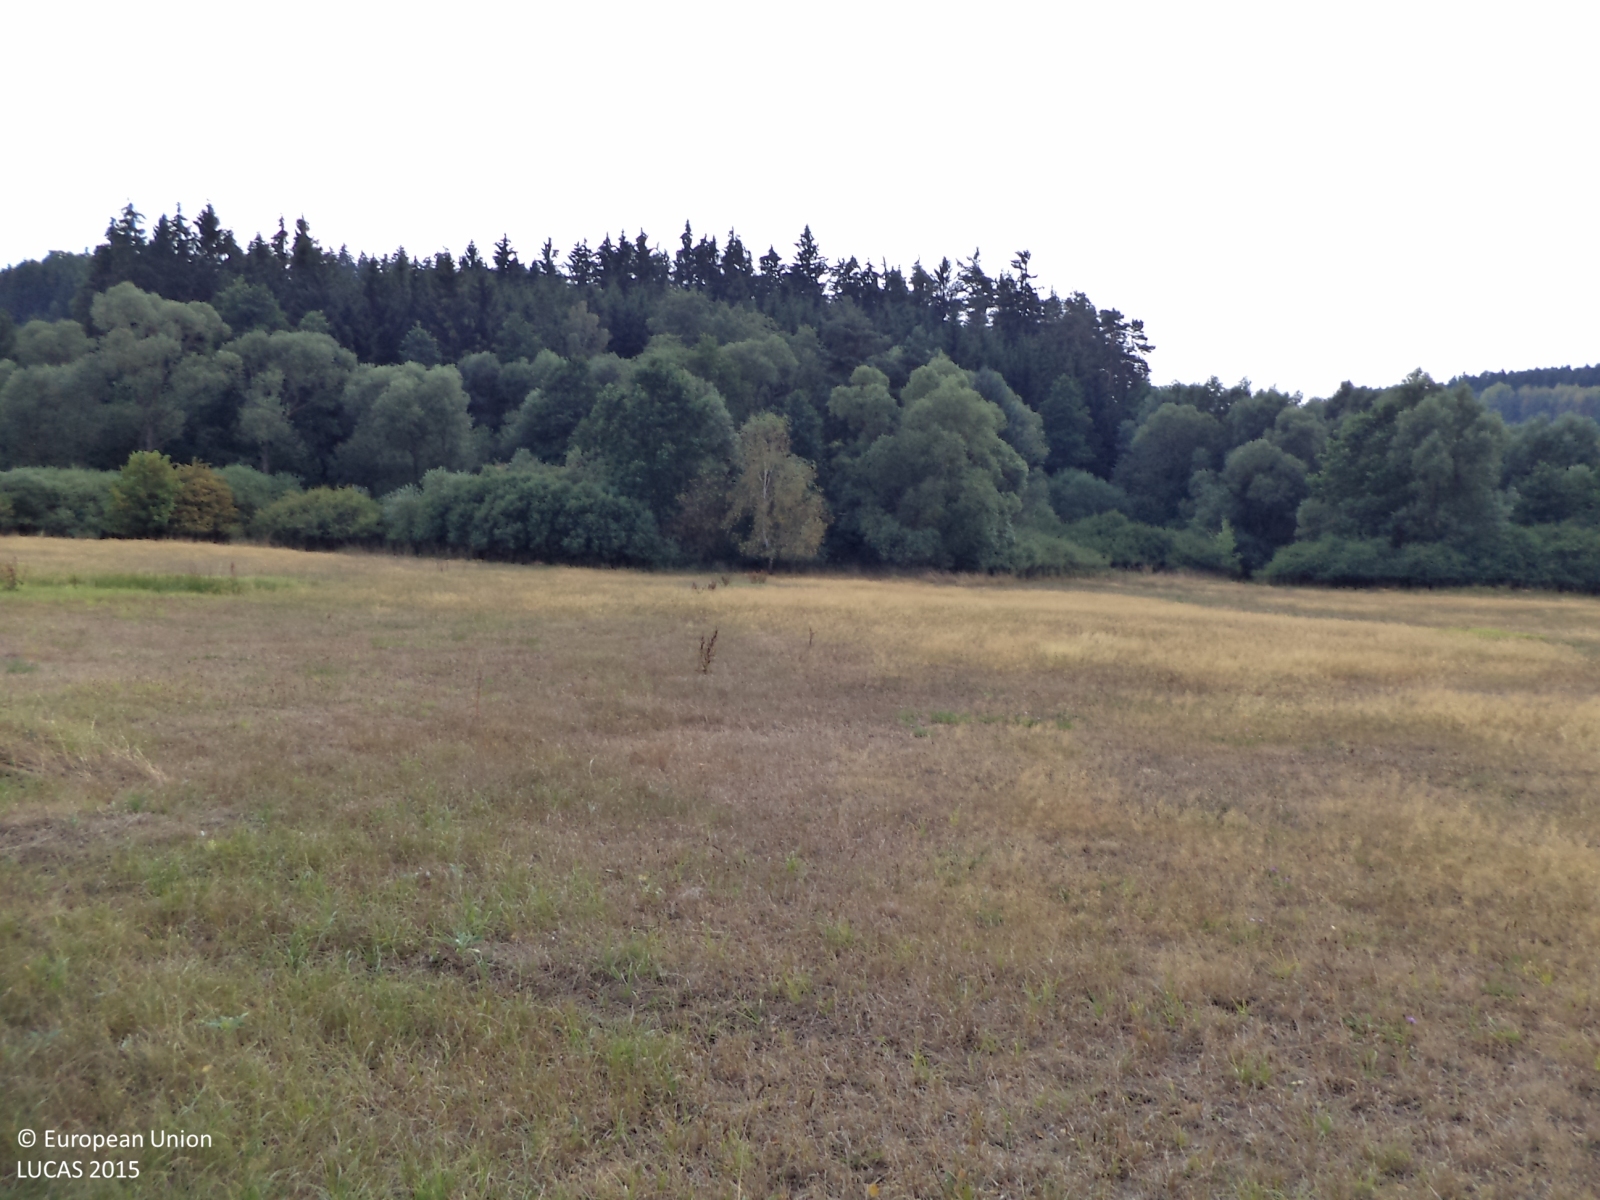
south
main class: Grassland
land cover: Grassland without tree/shrub cover
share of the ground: > 75 %
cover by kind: herbaceous plants 100 %
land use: Agriculture (excluding fallow land and kitchen gardens)
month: August
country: CZ
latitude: 49.4667
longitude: 14.4583
